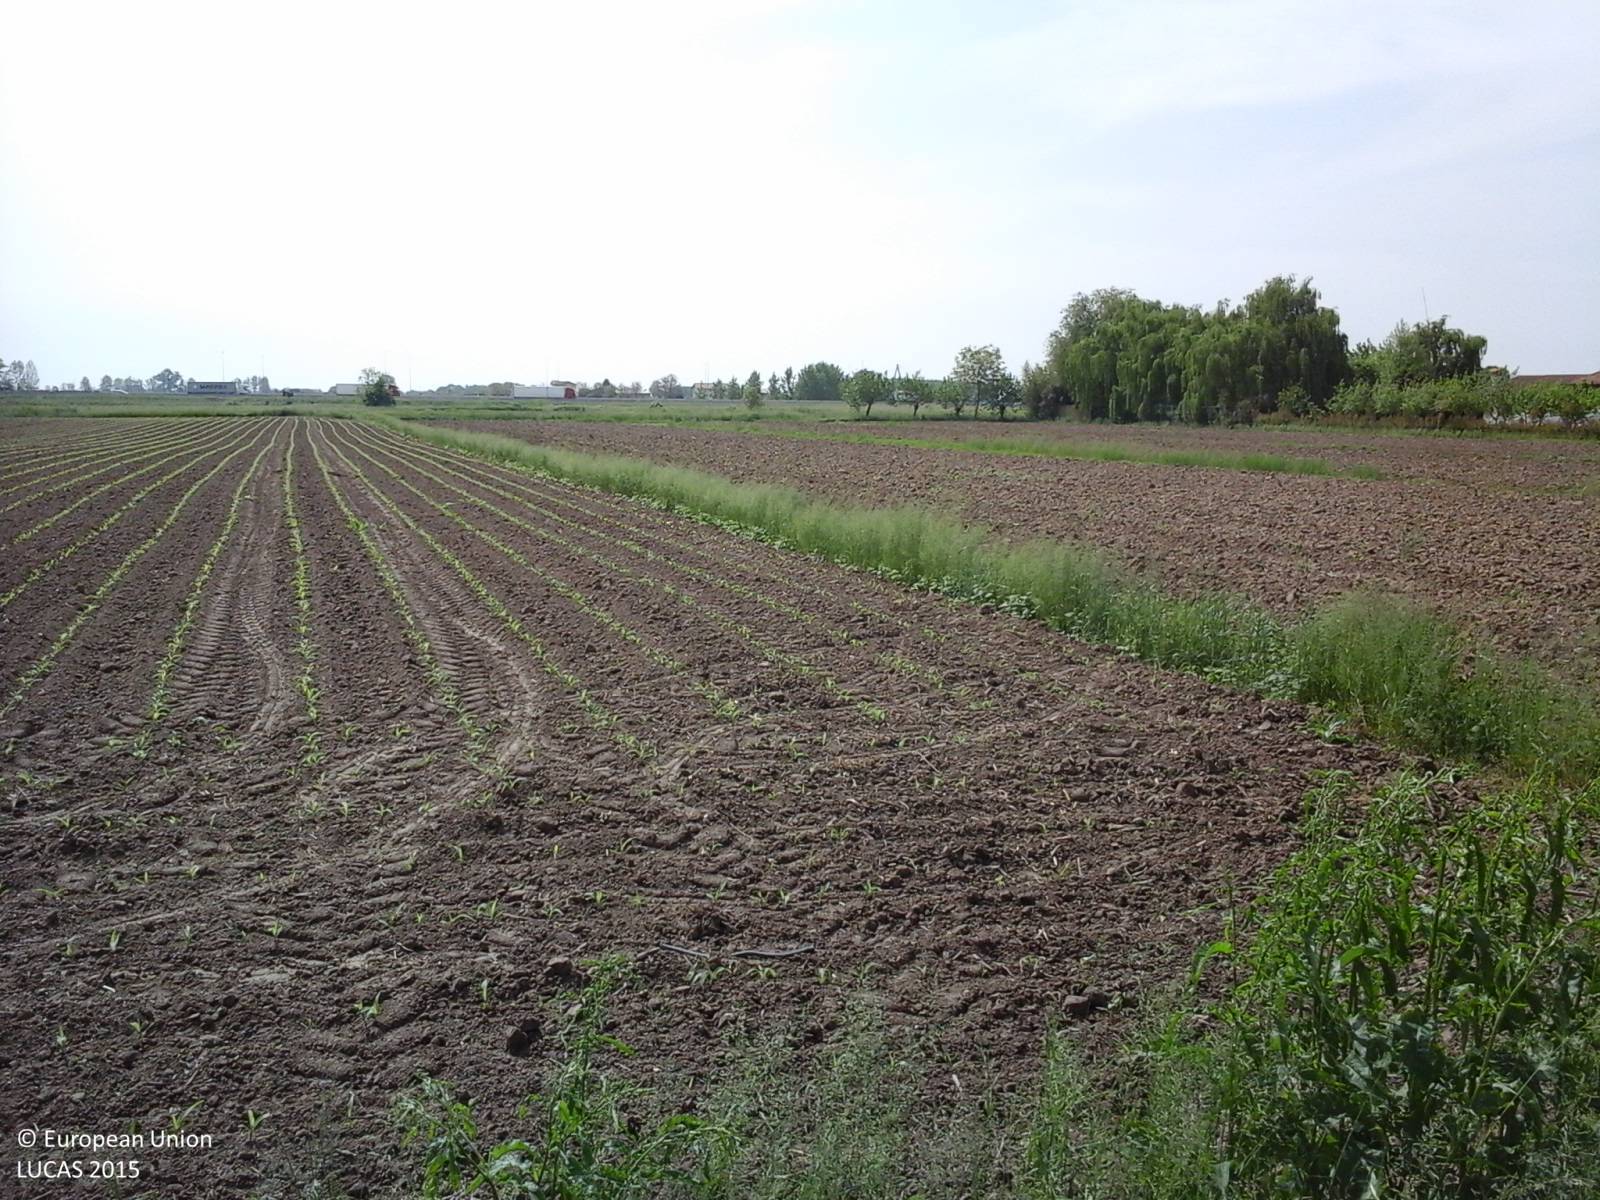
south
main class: Cropland
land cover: Maize
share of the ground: < 10 %
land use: Agriculture (excluding fallow land and kitchen gardens)
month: May
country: IT
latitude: 45.8218
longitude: 13.0209
